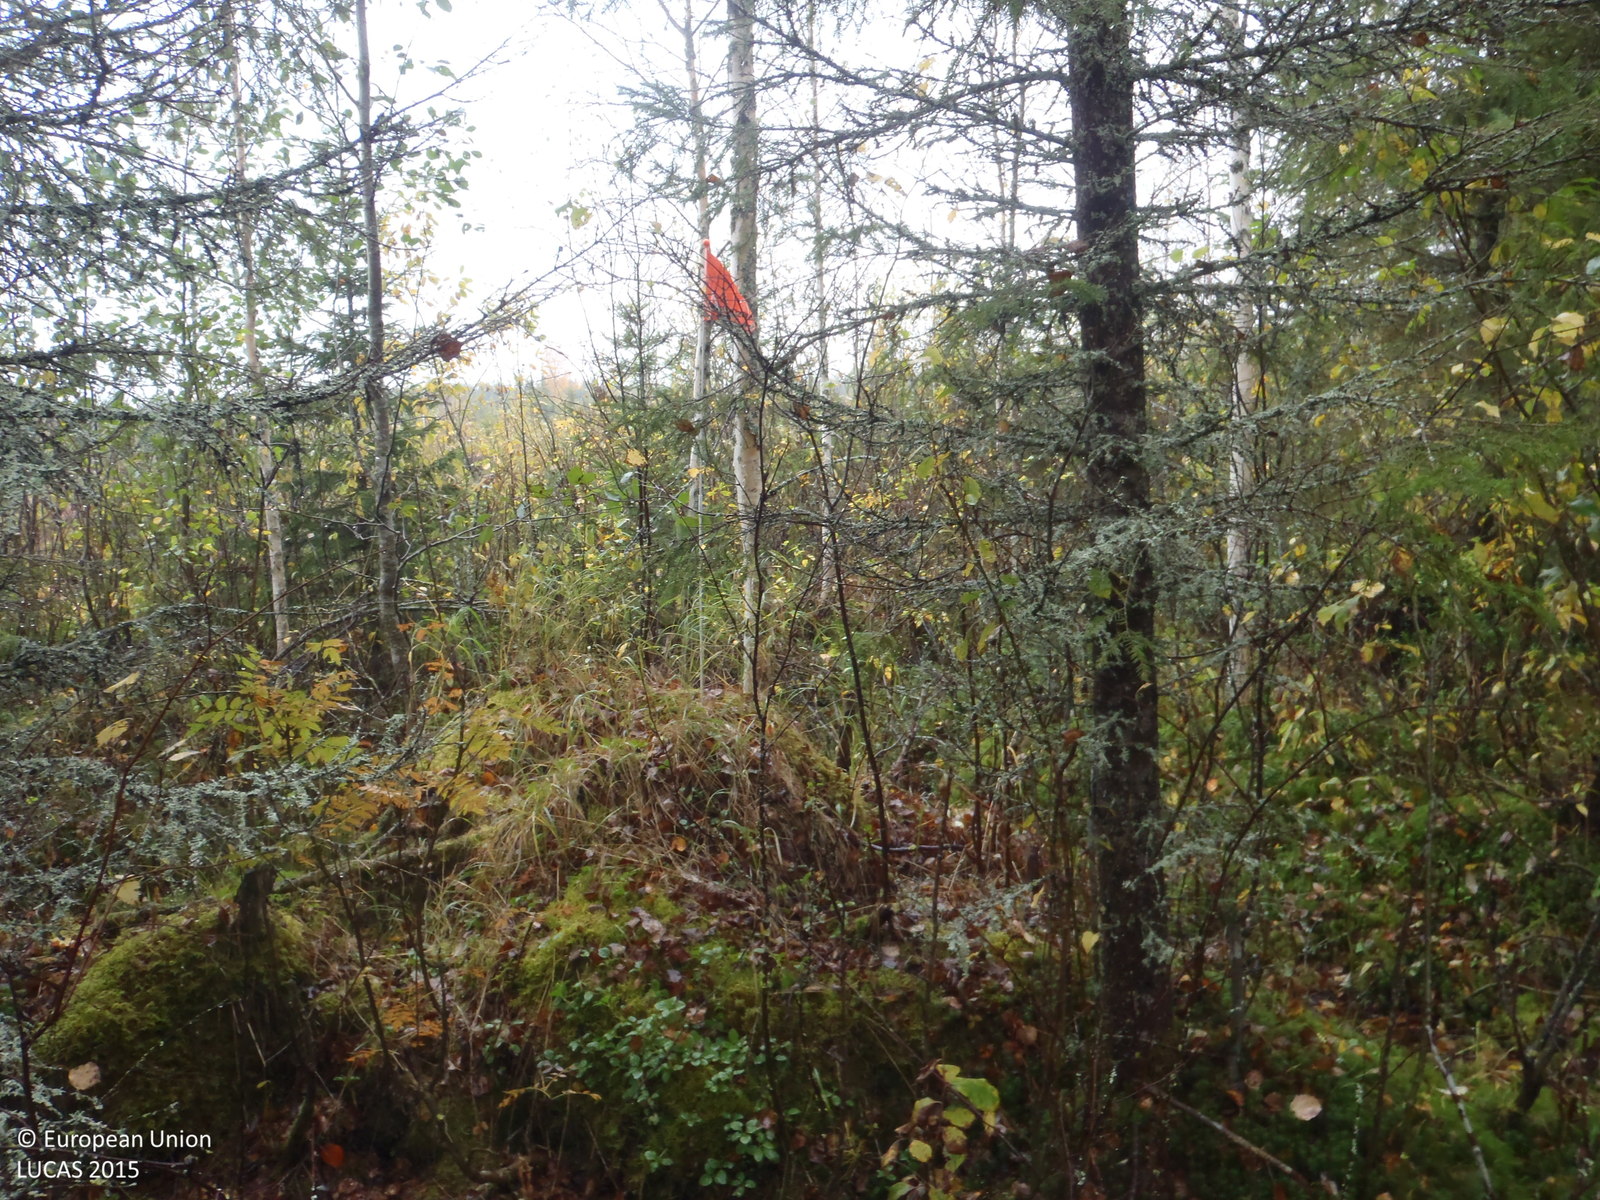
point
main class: Woodland
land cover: Spruce dominated coniferous woodland
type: boreal forest
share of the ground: > 75 %
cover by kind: coniferous forest trees 70 %, broadleaved forest trees 20 %, shrubs 5 %, herbaceous plants 5 %
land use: Forestry
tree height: > 5 m
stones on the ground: < 10 %
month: September
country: FI
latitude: 65.1569
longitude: 26.5104
